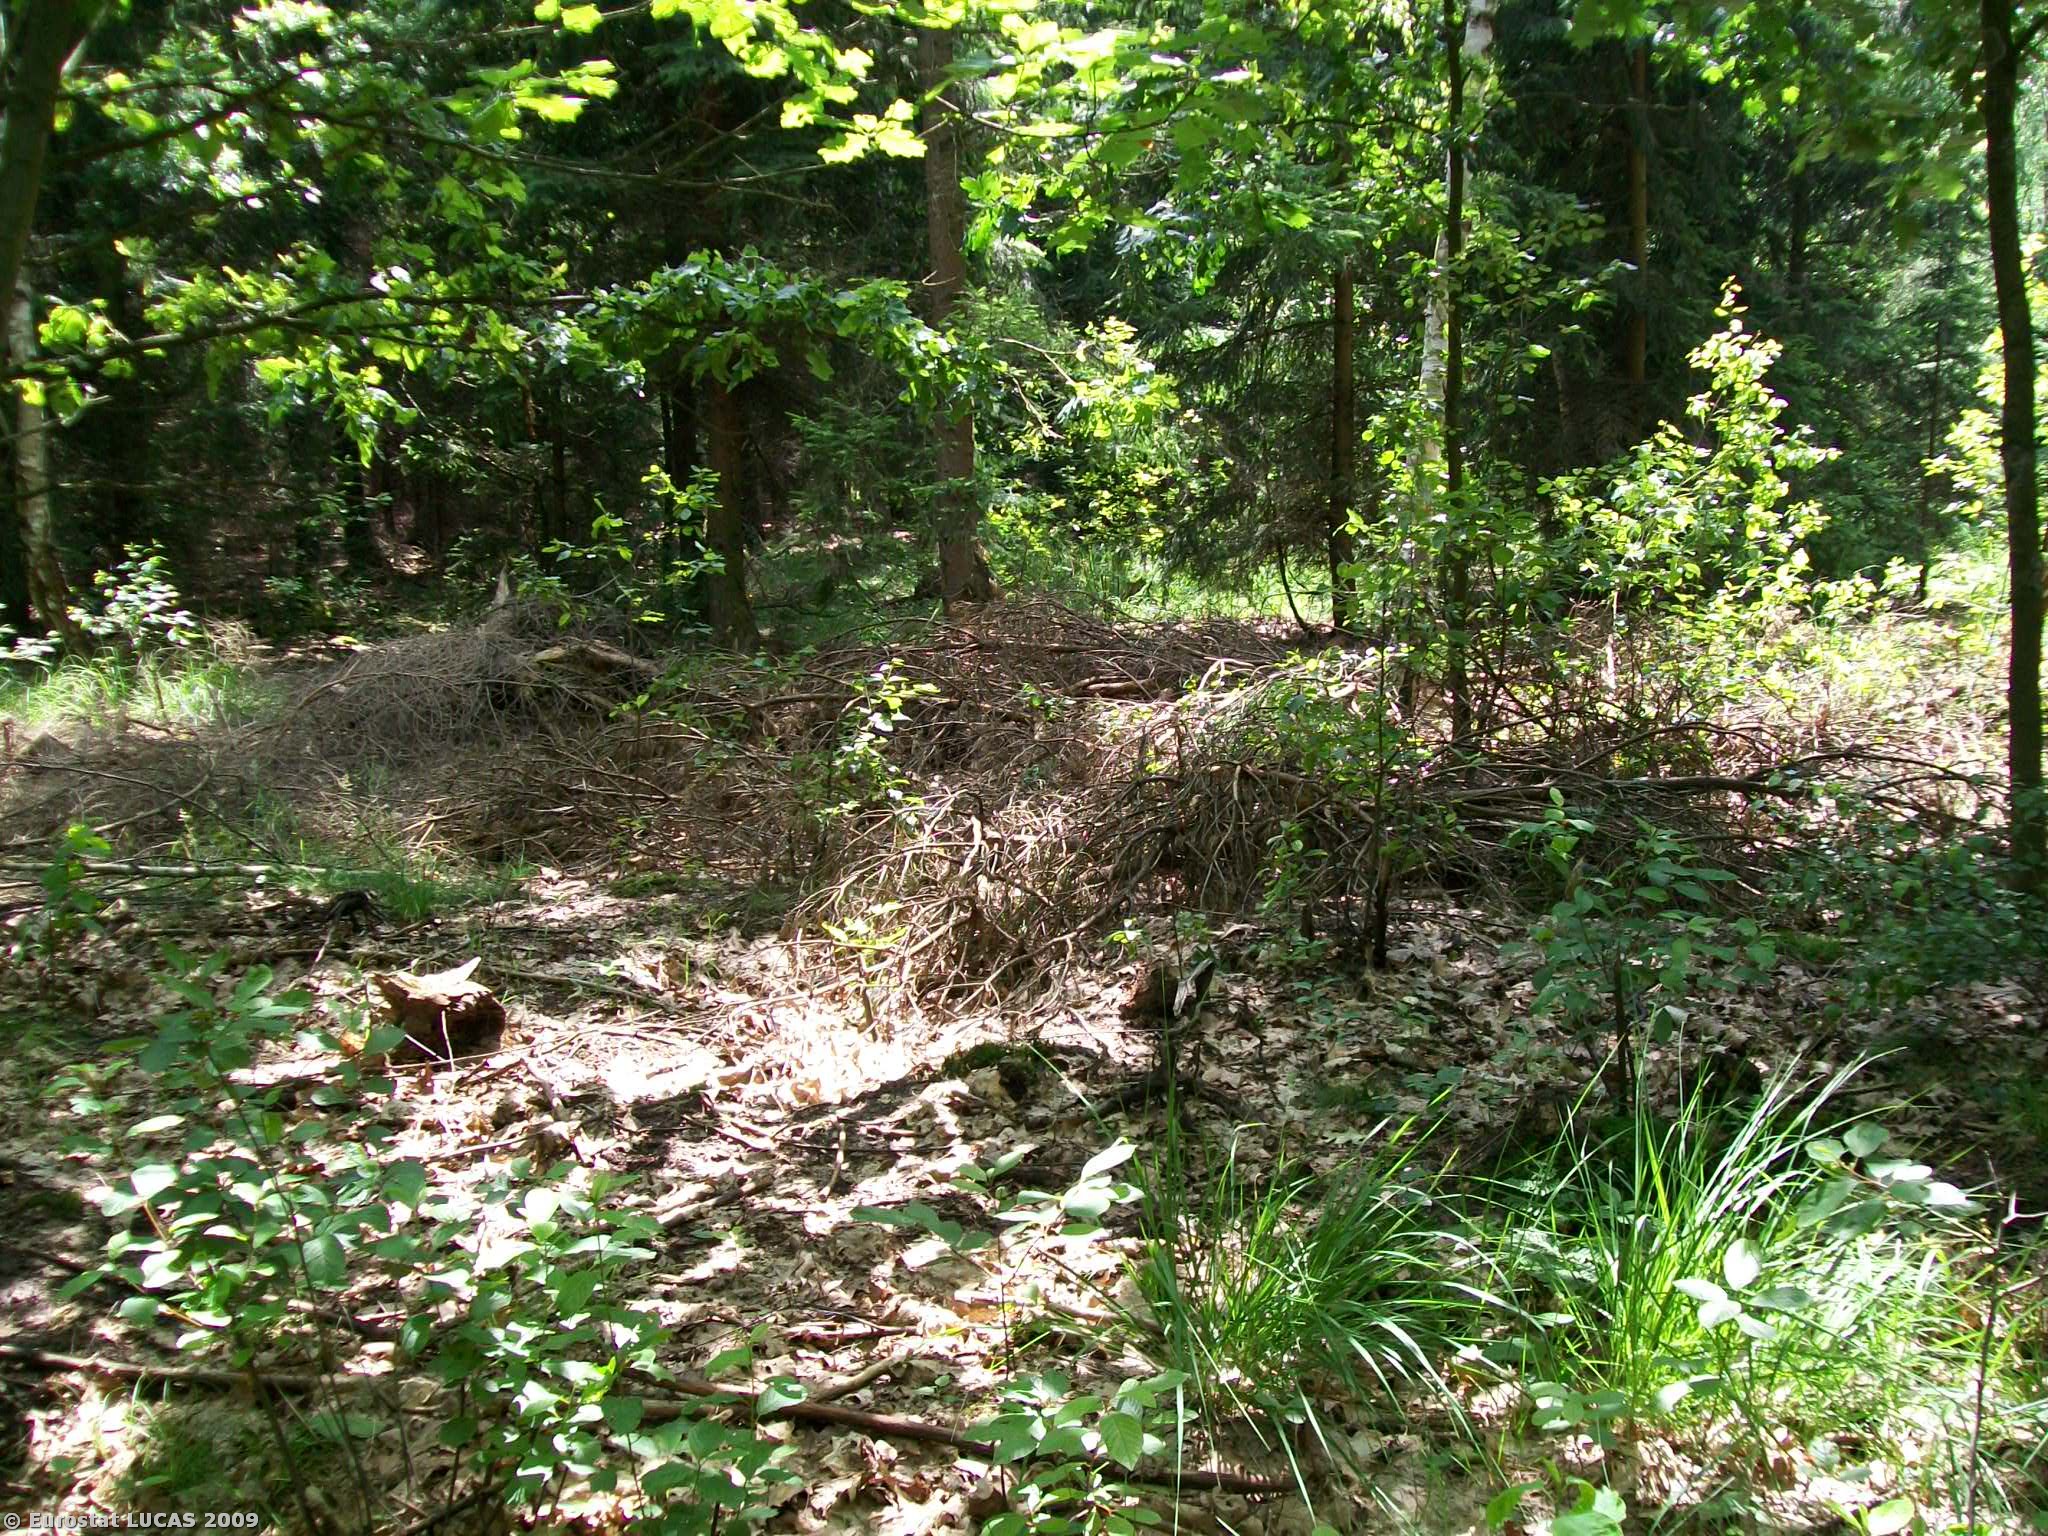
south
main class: Woodland
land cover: Coniferous woodland
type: hemiboreal forest and nemoral coniferous forest and mixed broadleaved-coniferous forest
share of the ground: > 75 %
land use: Unused
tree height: > 5 m
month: July
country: PL
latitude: 51.1736
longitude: 16.7745
